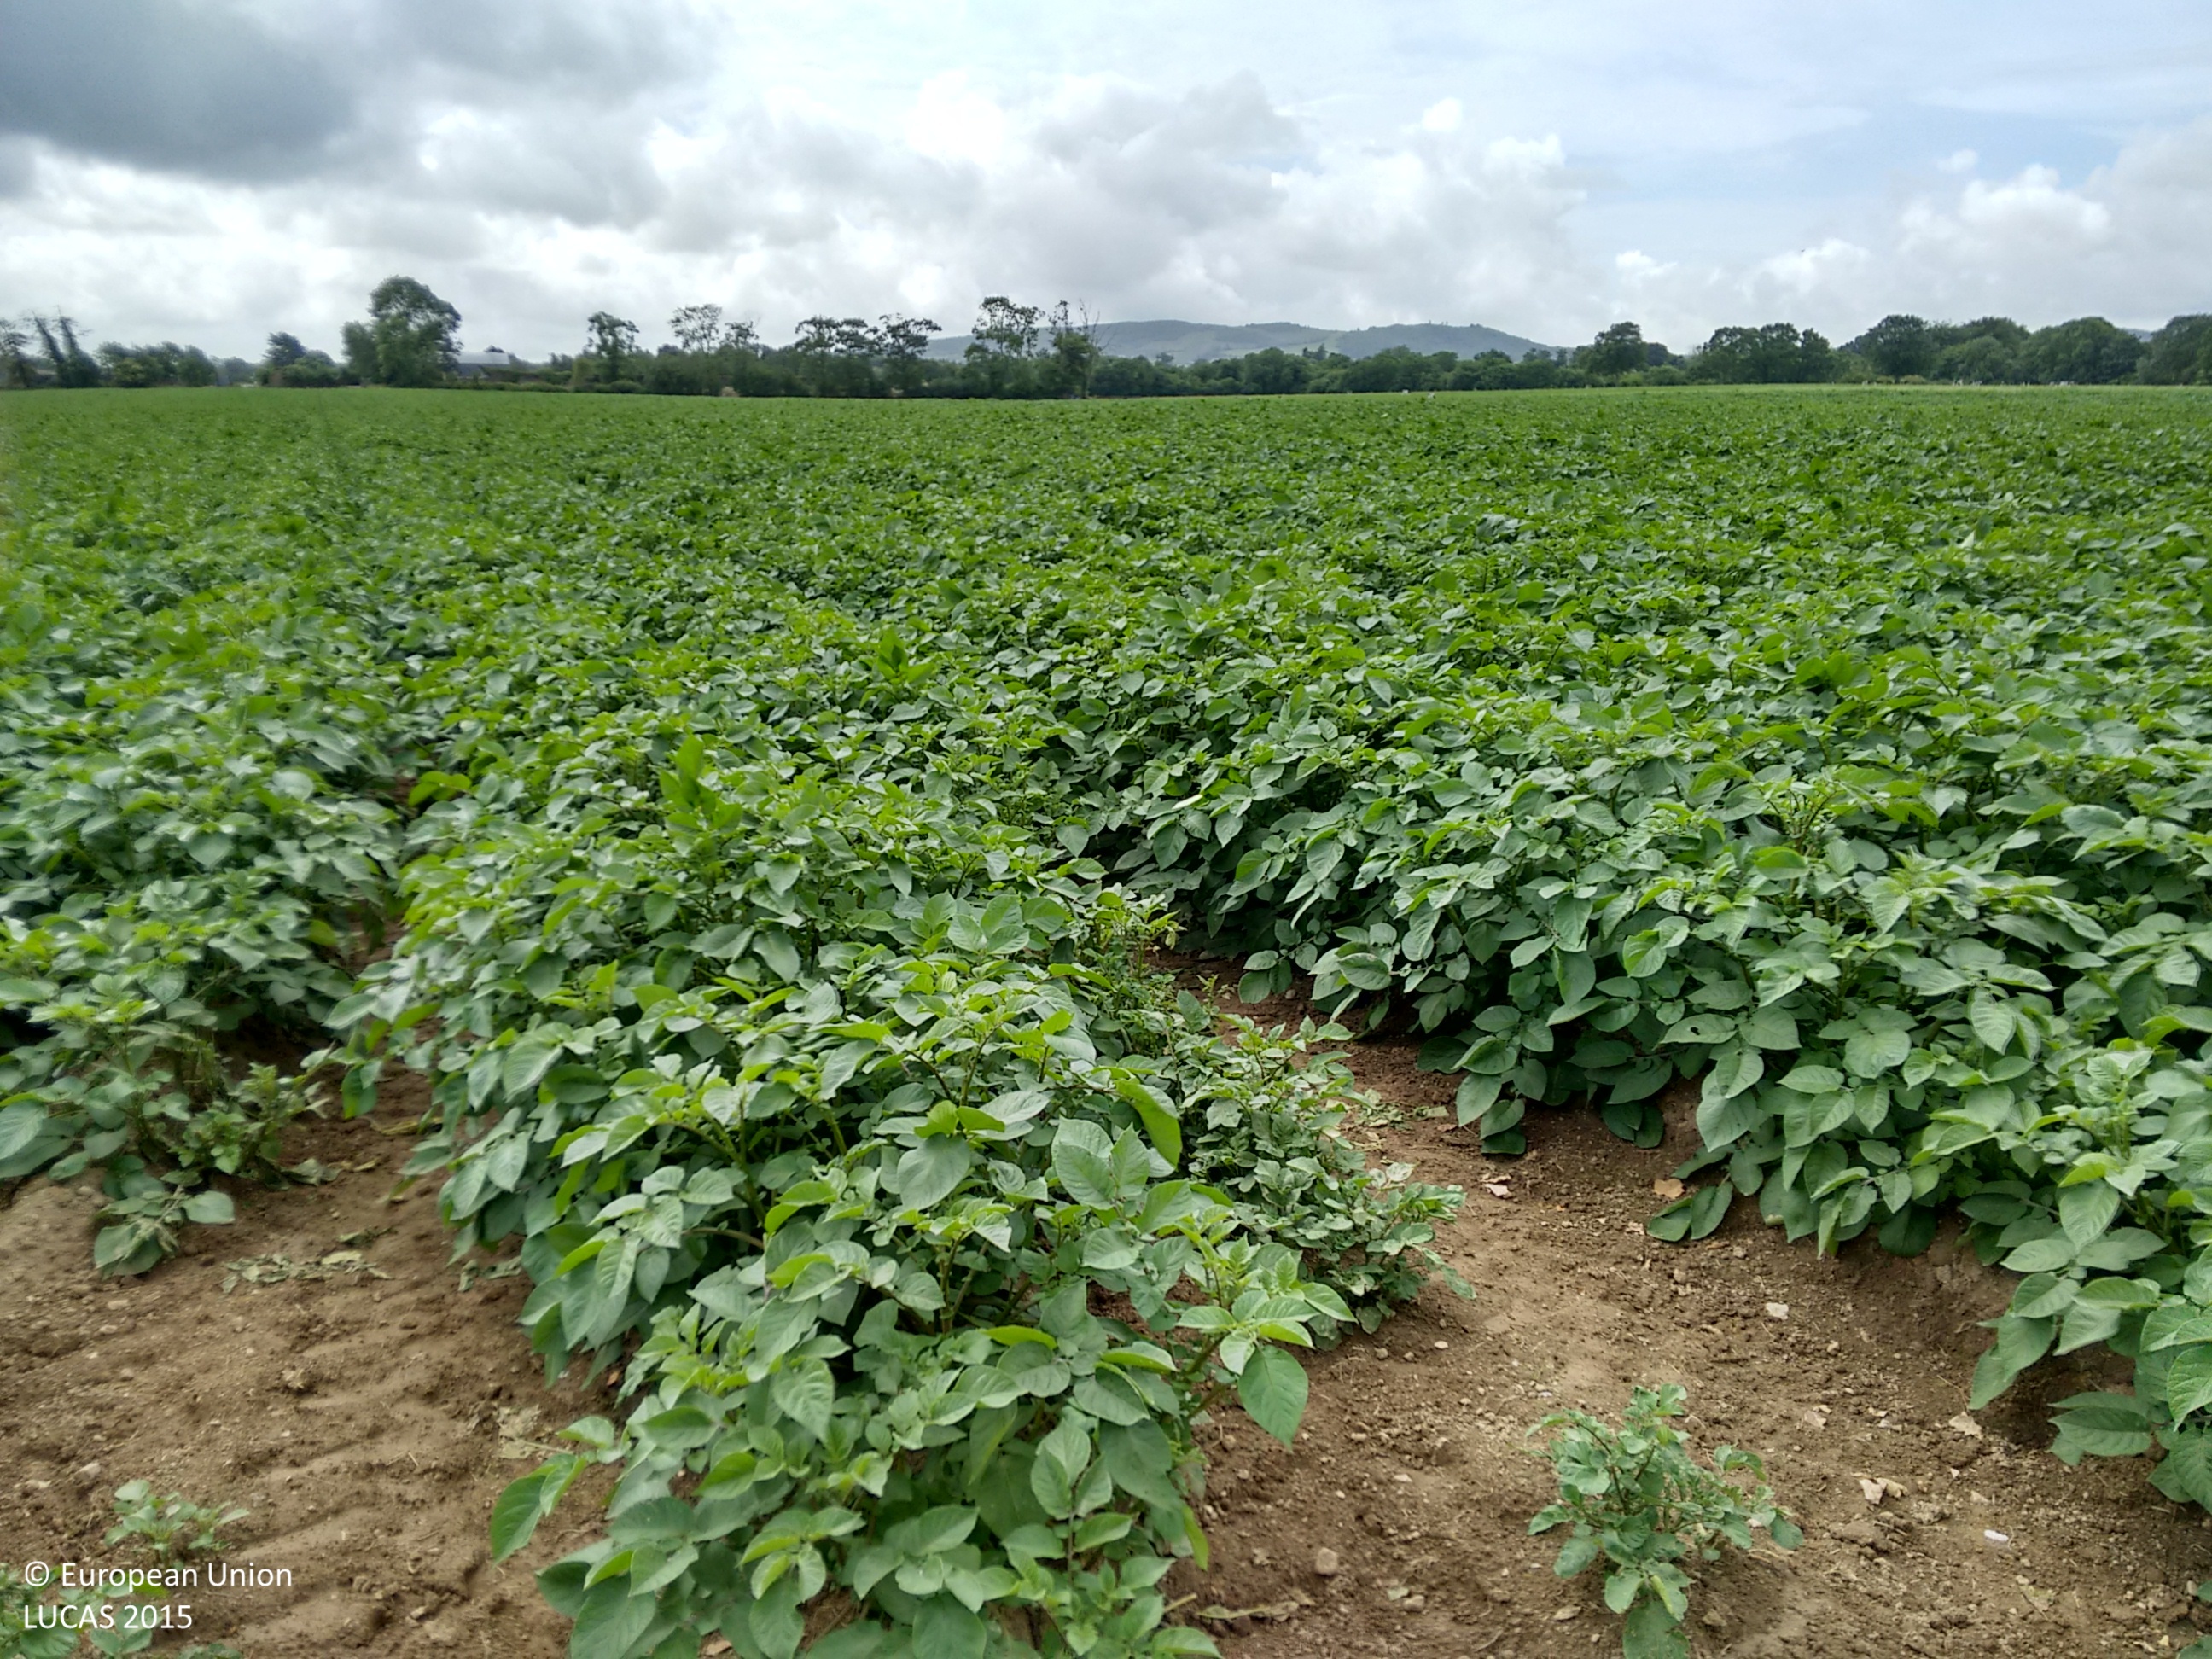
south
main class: Cropland
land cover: Potatoes
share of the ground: > 75 %
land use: Agriculture (excluding fallow land and kitchen gardens)
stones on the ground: < 10 %
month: June
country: IE
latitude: 52.3738
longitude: -7.3547
